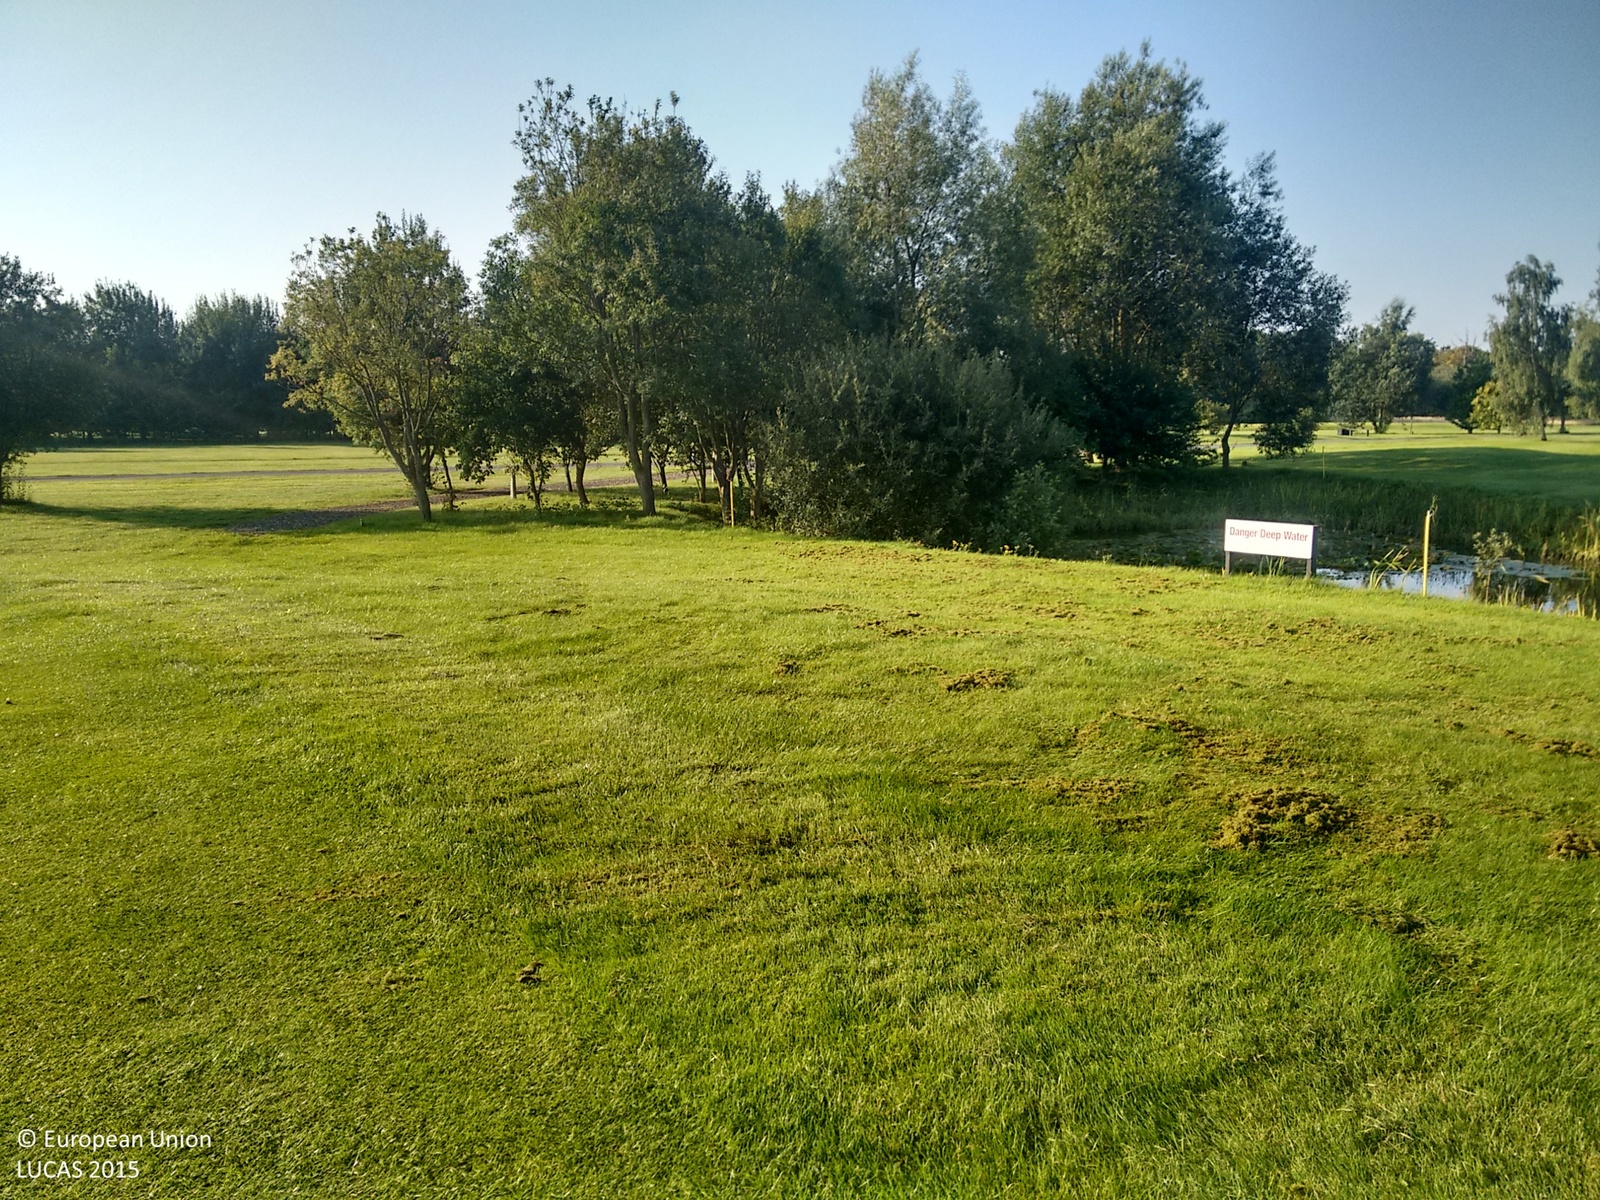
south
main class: Grassland
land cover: Grassland without tree/shrub cover
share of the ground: > 75 %
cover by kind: herbaceous plants 100 %
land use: Sport
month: September
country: GB
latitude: 52.2928
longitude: 1.5506
